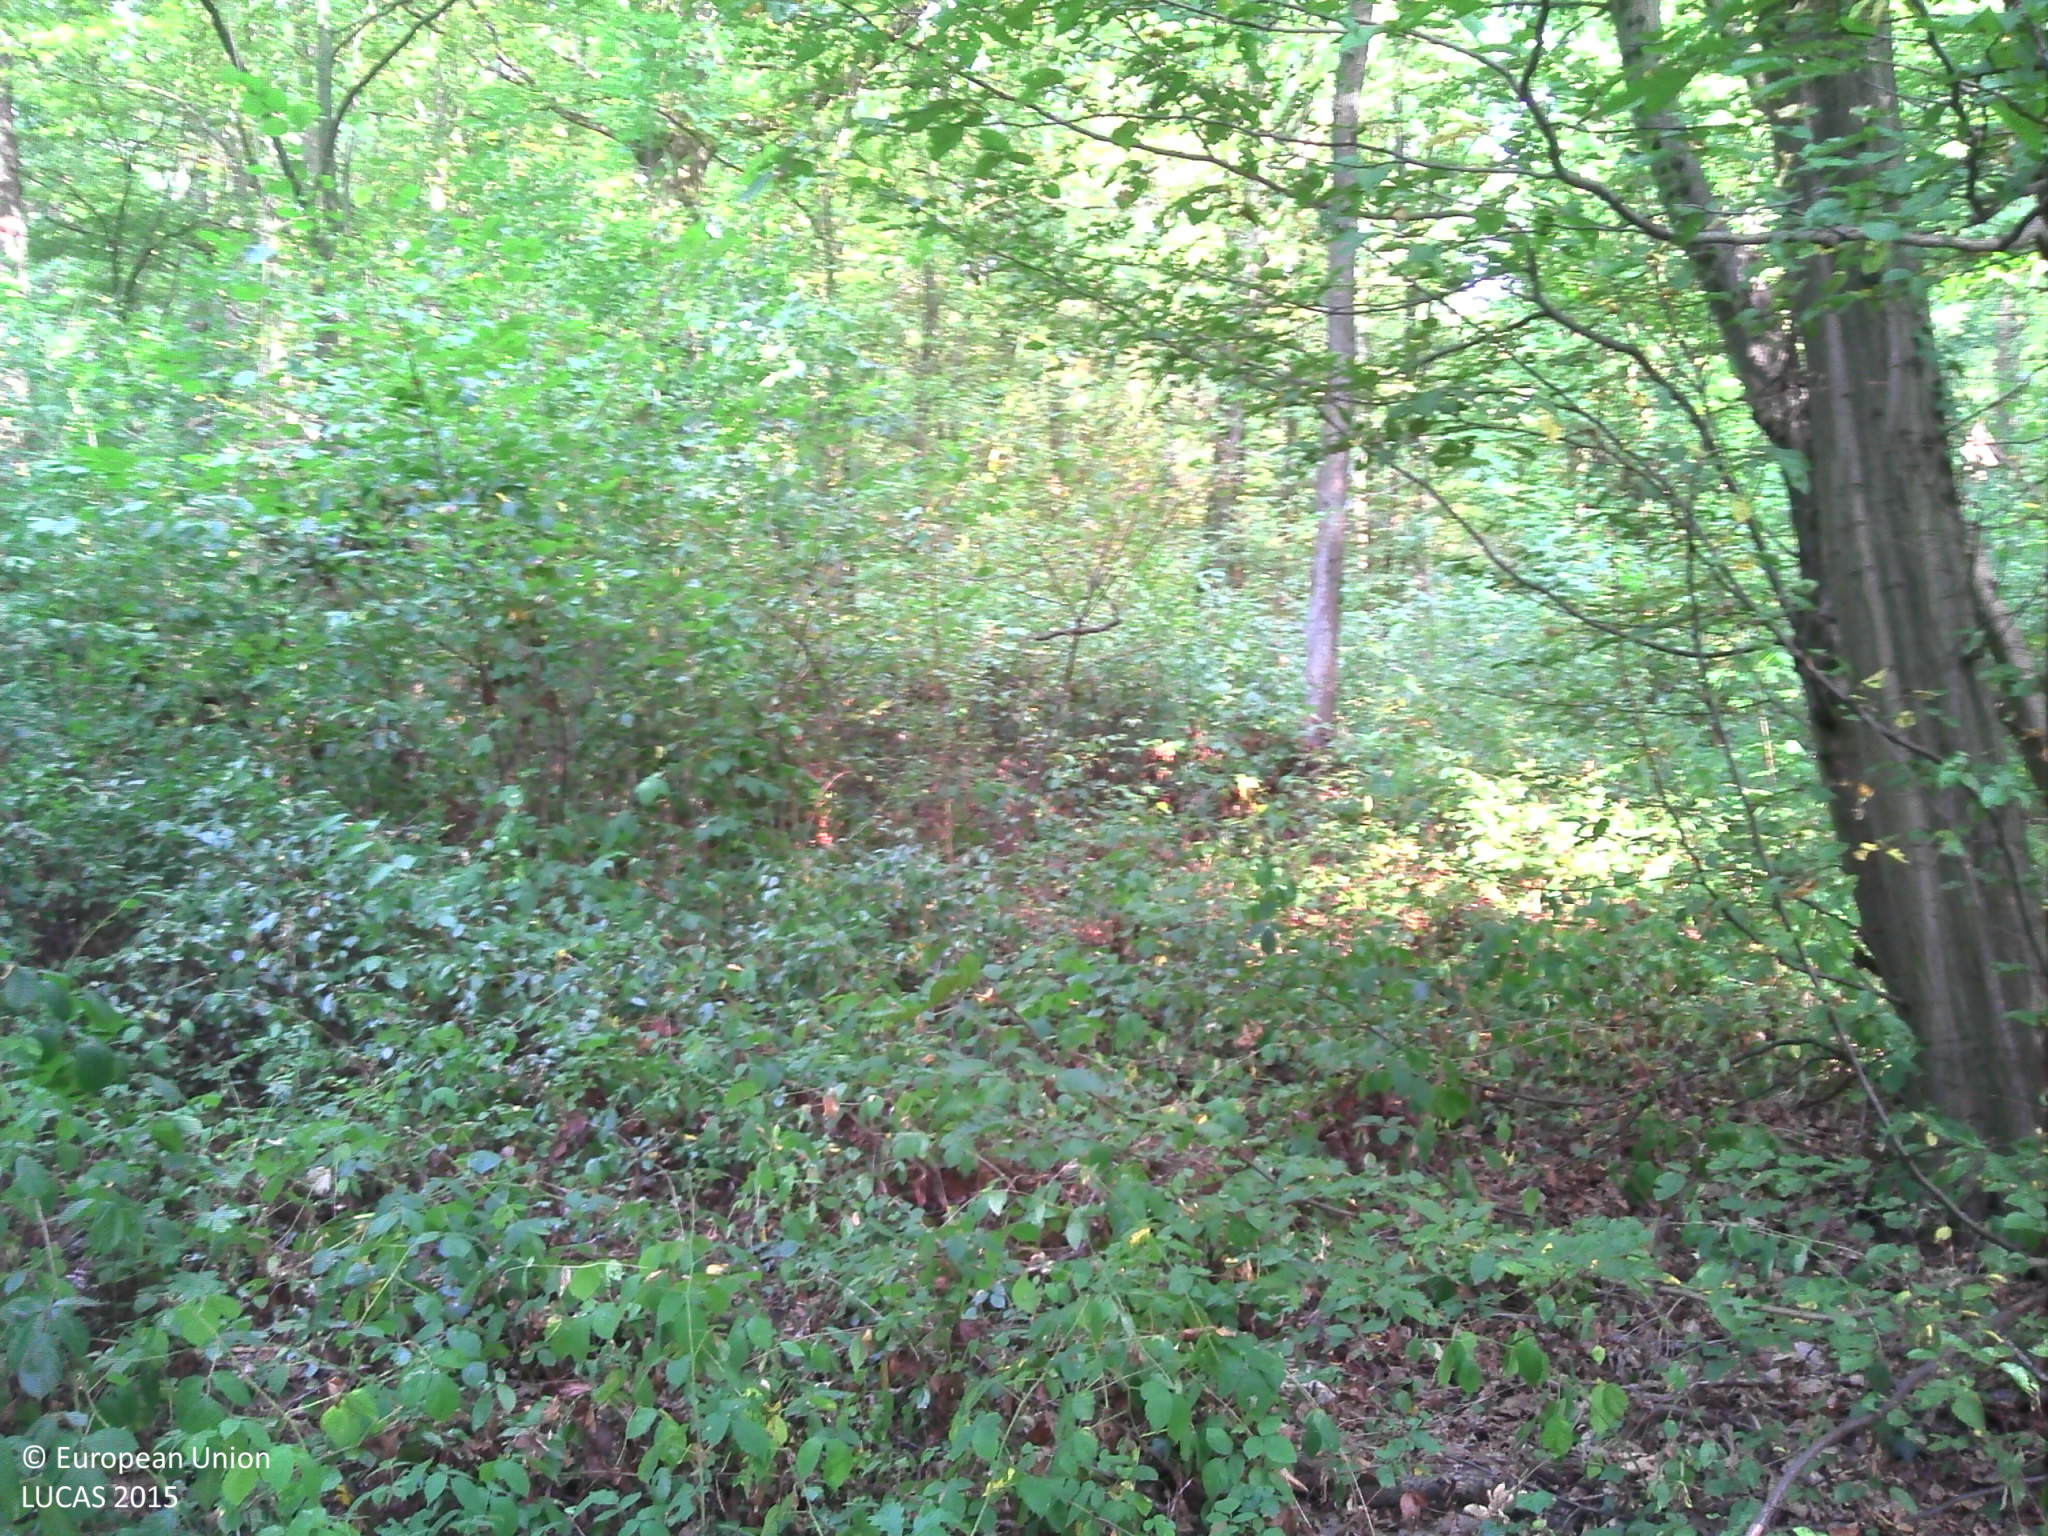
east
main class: Woodland
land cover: Broadleaved woodland
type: acidophilous oak and oak-birch forest
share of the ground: > 75 %
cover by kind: broadleaved forest trees 60 %, herbaceous plants 15 %, lichens and mosses 15 %, unconsolidated bare surface 10 %
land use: Forestry
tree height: > 5 m
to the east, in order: Broadleaved woodland
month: August
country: FR
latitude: 48.9182
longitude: 2.6614
